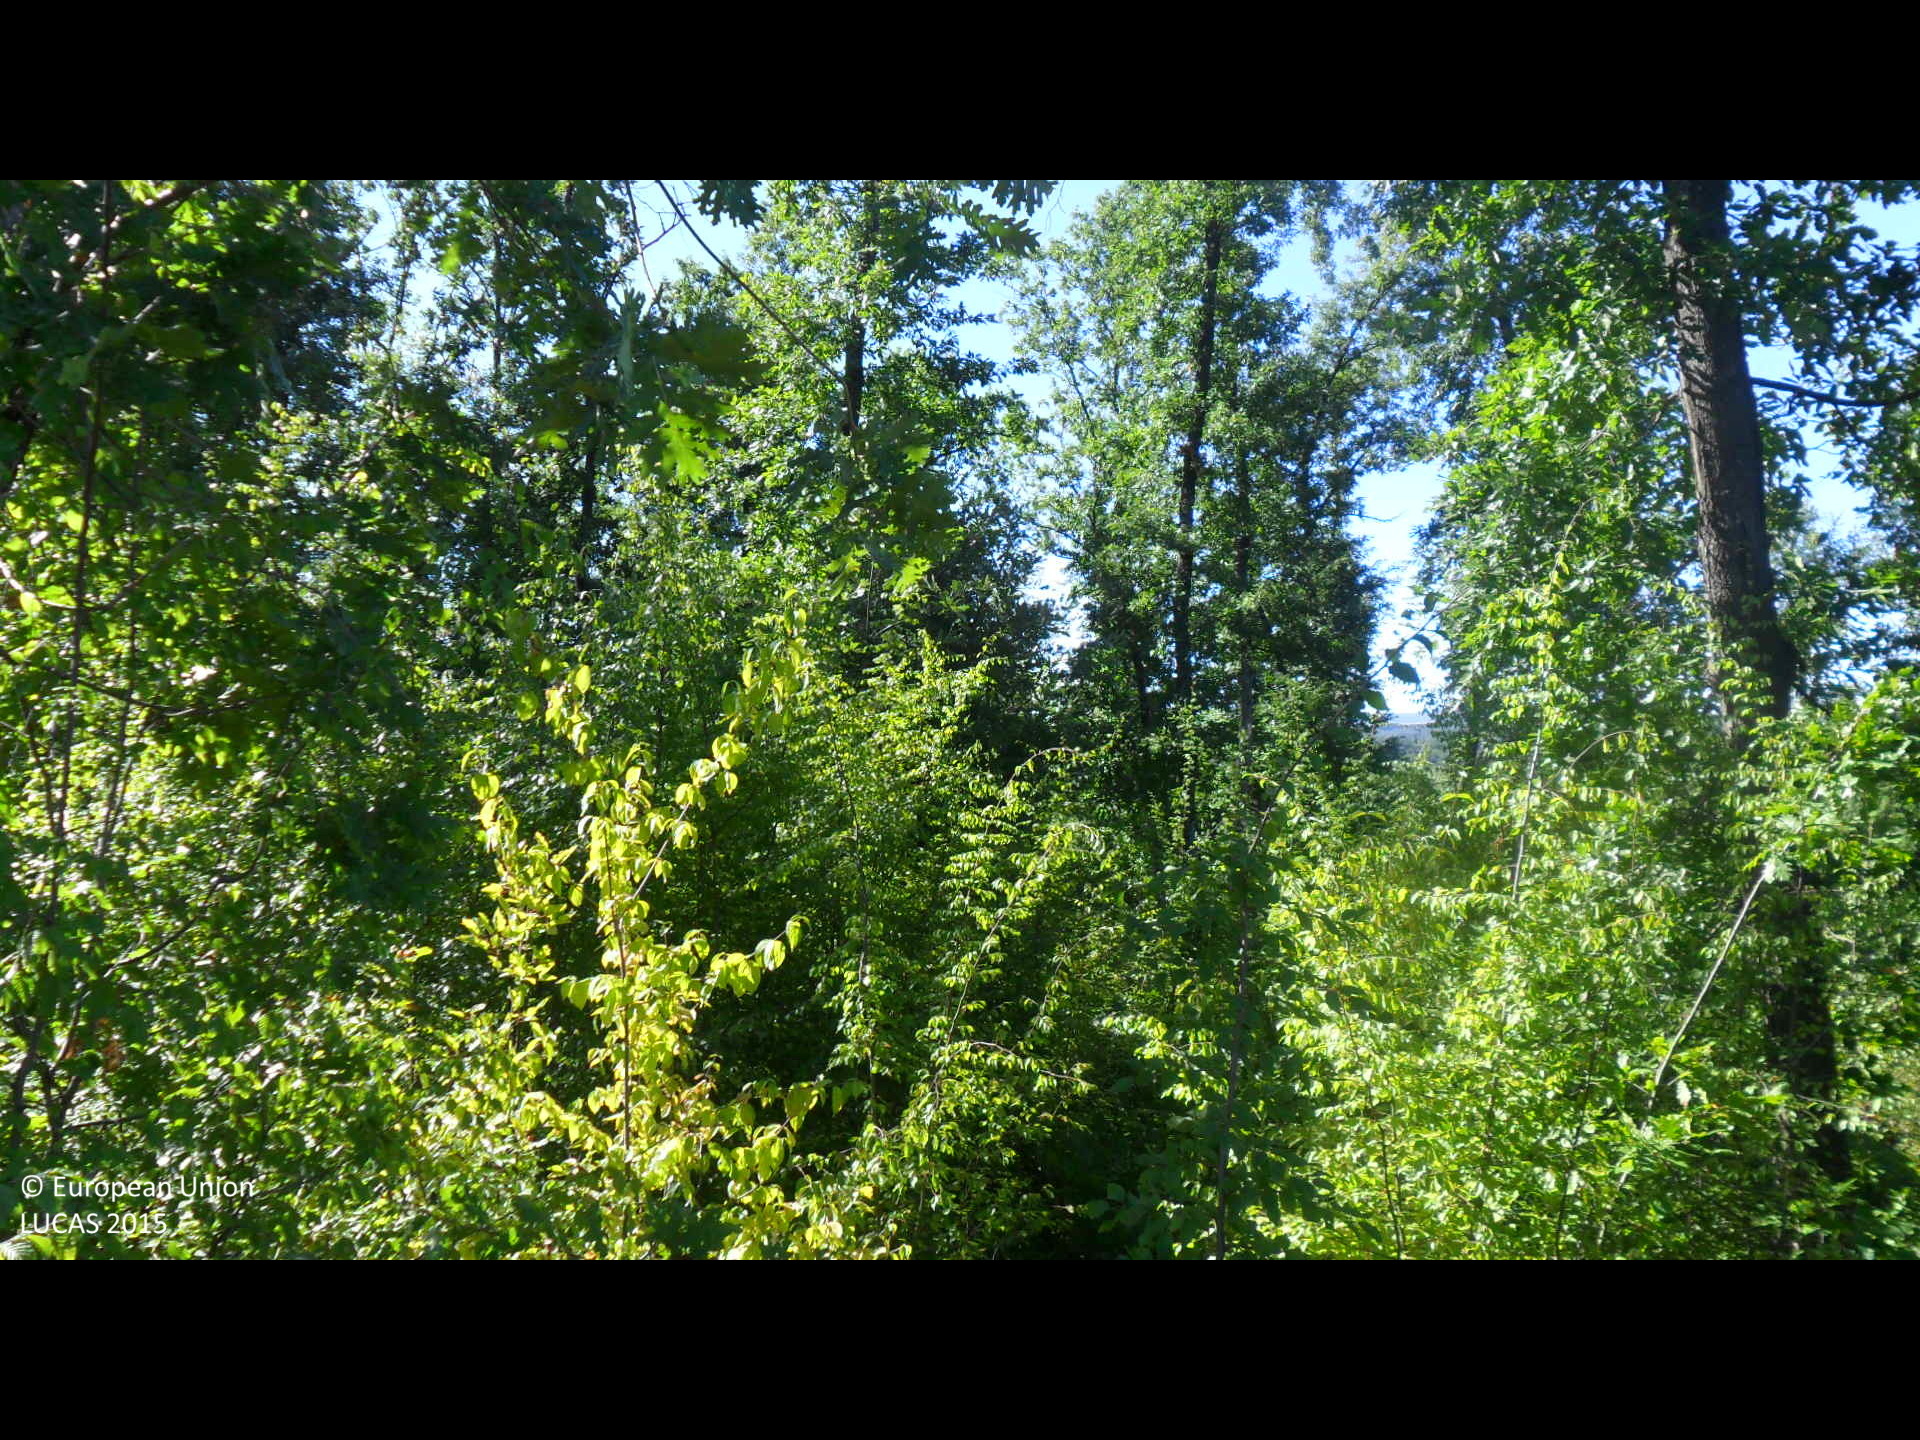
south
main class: Woodland
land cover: Broadleaved woodland
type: thermophilous deciduous forest
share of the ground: > 75 %
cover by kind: broadleaved forest trees 95 %, unconsolidated bare surface 5 %
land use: Forestry
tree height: > 5 m
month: September
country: BG
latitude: 43.1625
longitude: 26.2937
